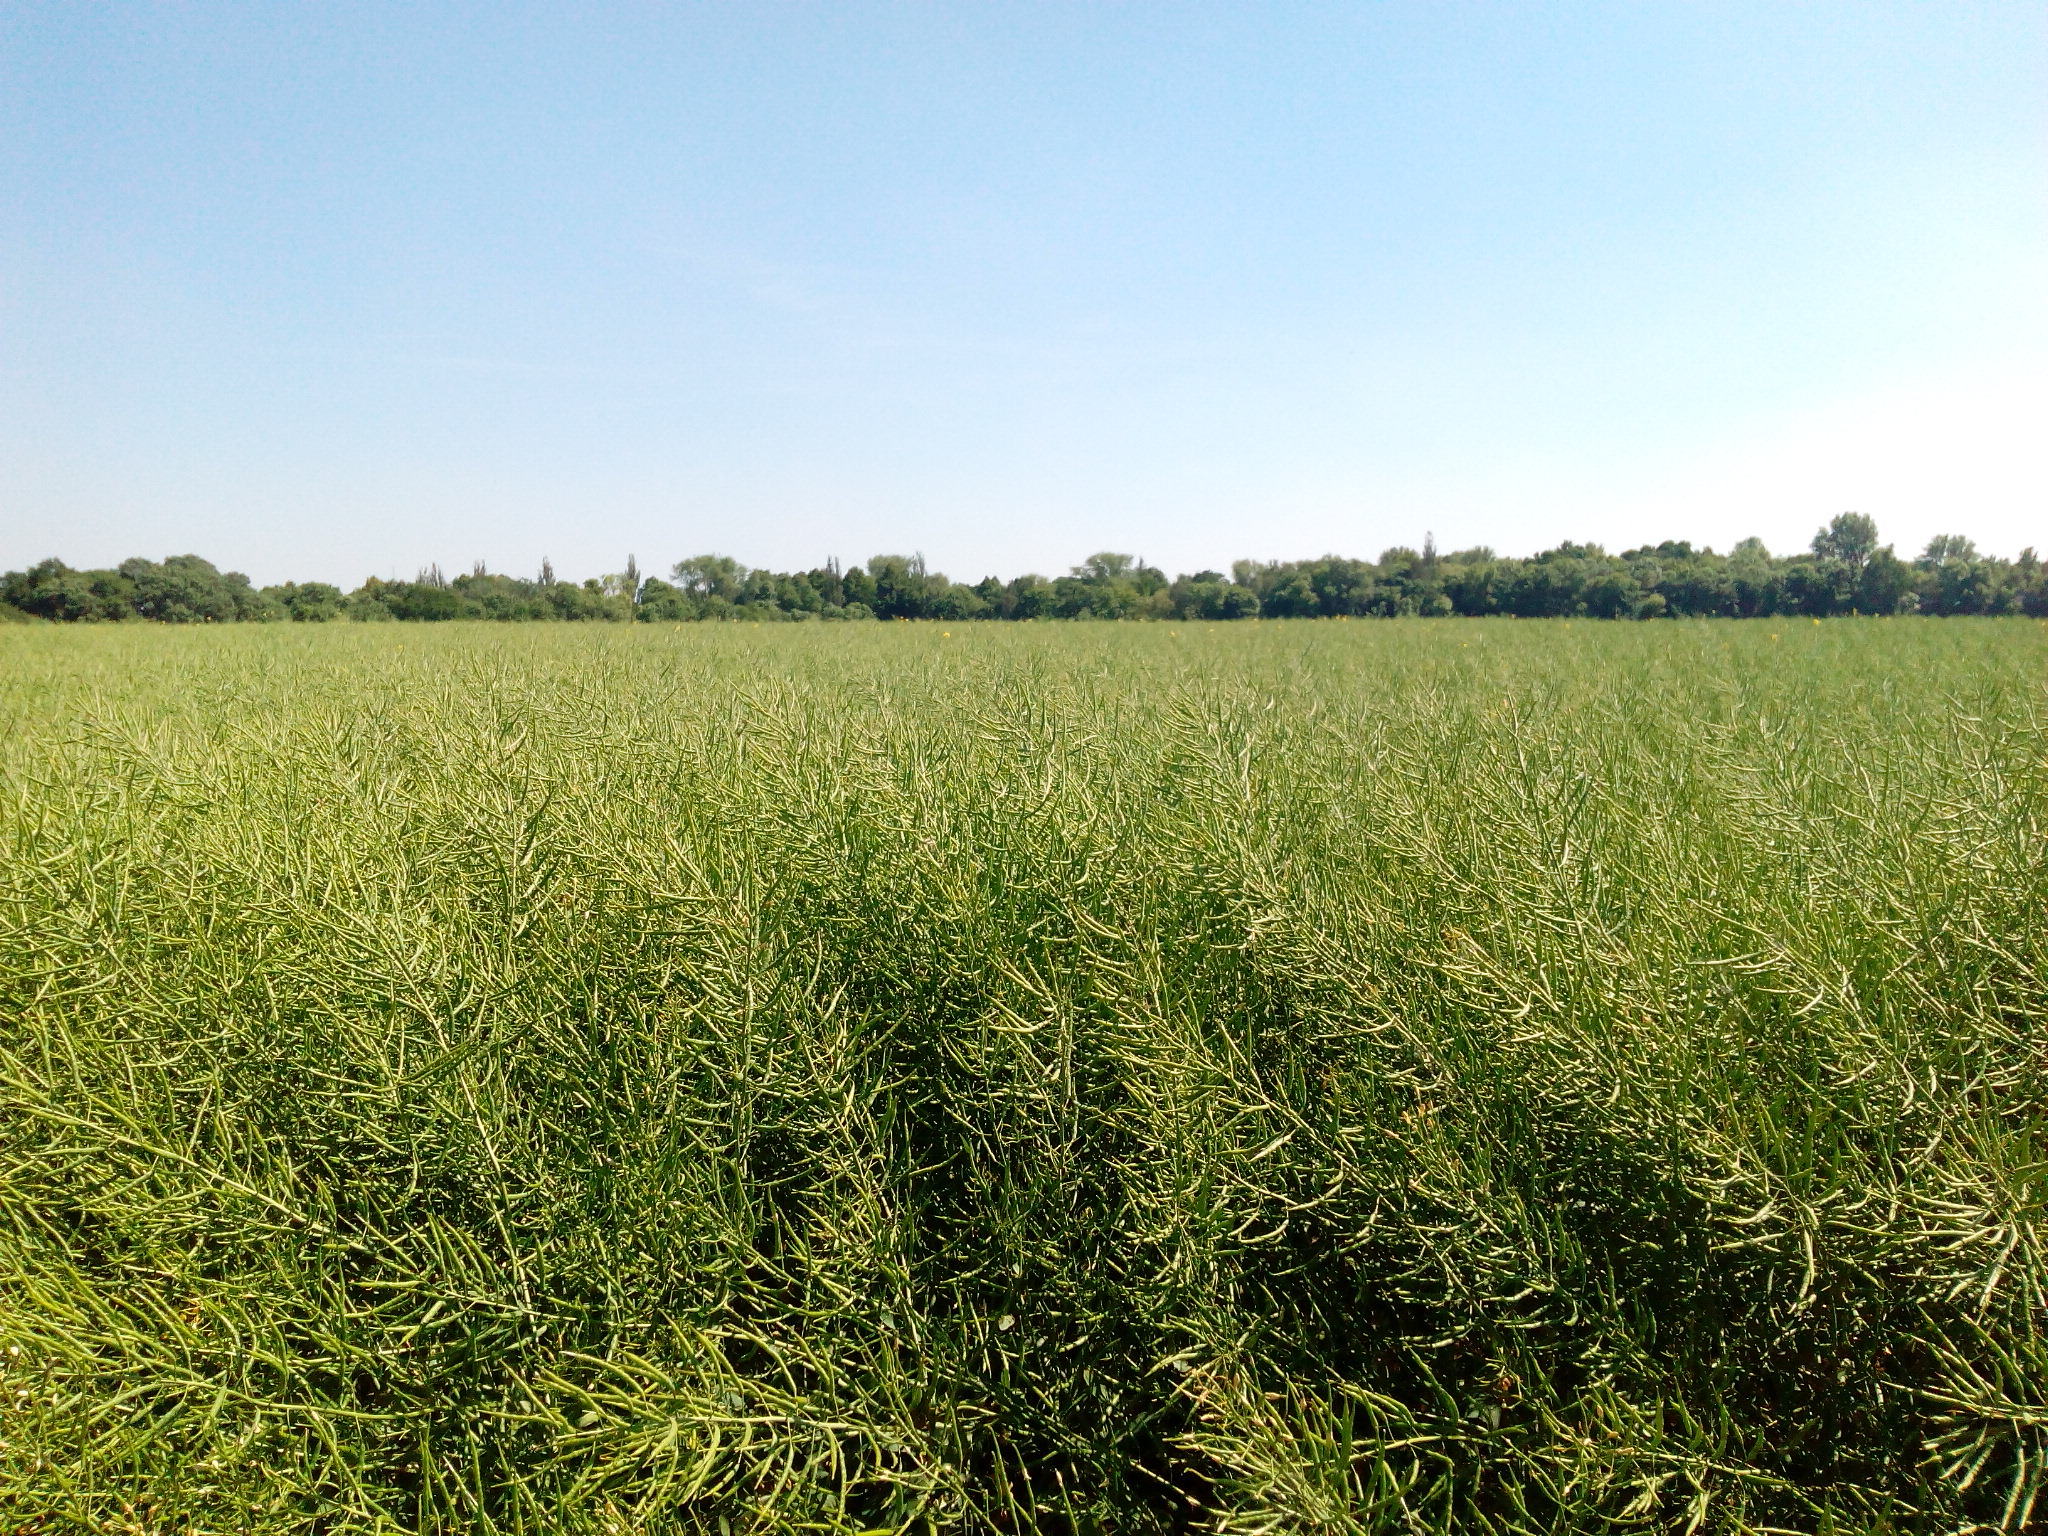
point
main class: Cropland
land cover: Rape and turnip rape
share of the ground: > 75 %
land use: Agriculture (excluding fallow land and kitchen gardens)
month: June
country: DE
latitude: 52.2876
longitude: 9.9267
